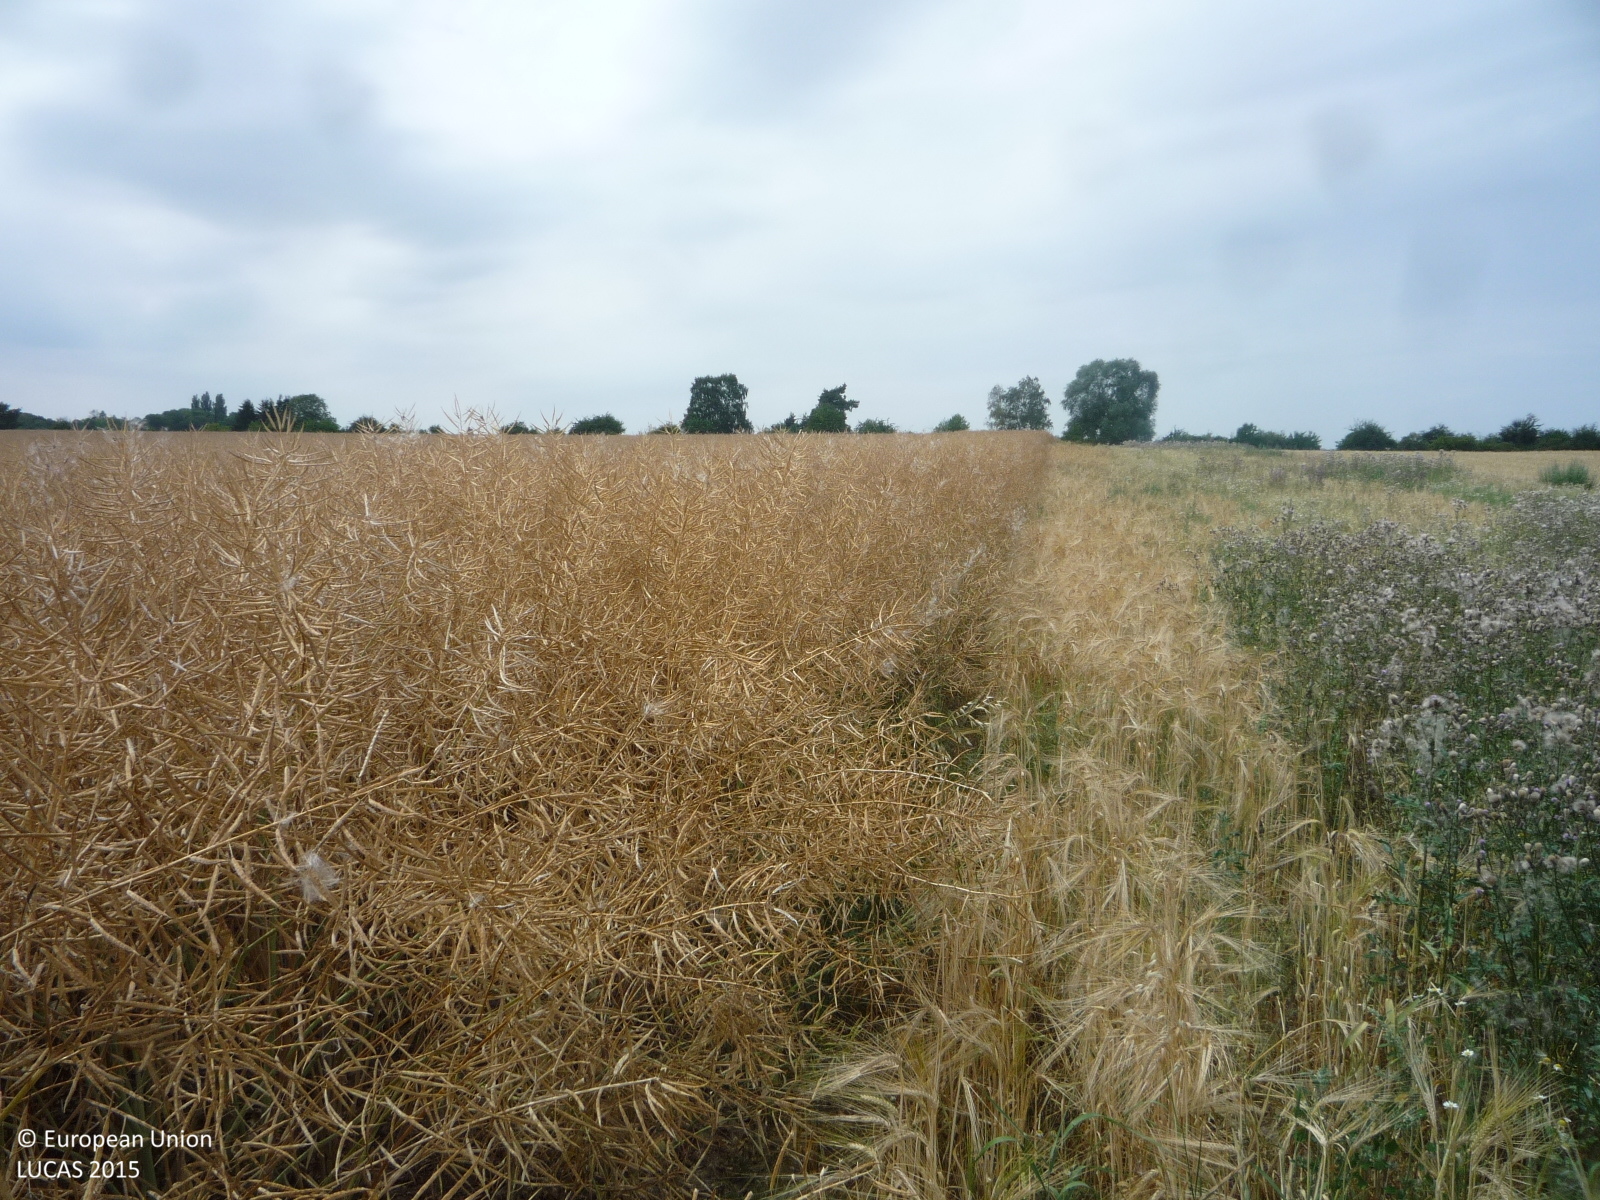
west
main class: Cropland
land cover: Rape and turnip rape
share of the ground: > 75 %
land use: Agriculture (excluding fallow land and kitchen gardens)
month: July
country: CZ
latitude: 50.2759
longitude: 14.9278
